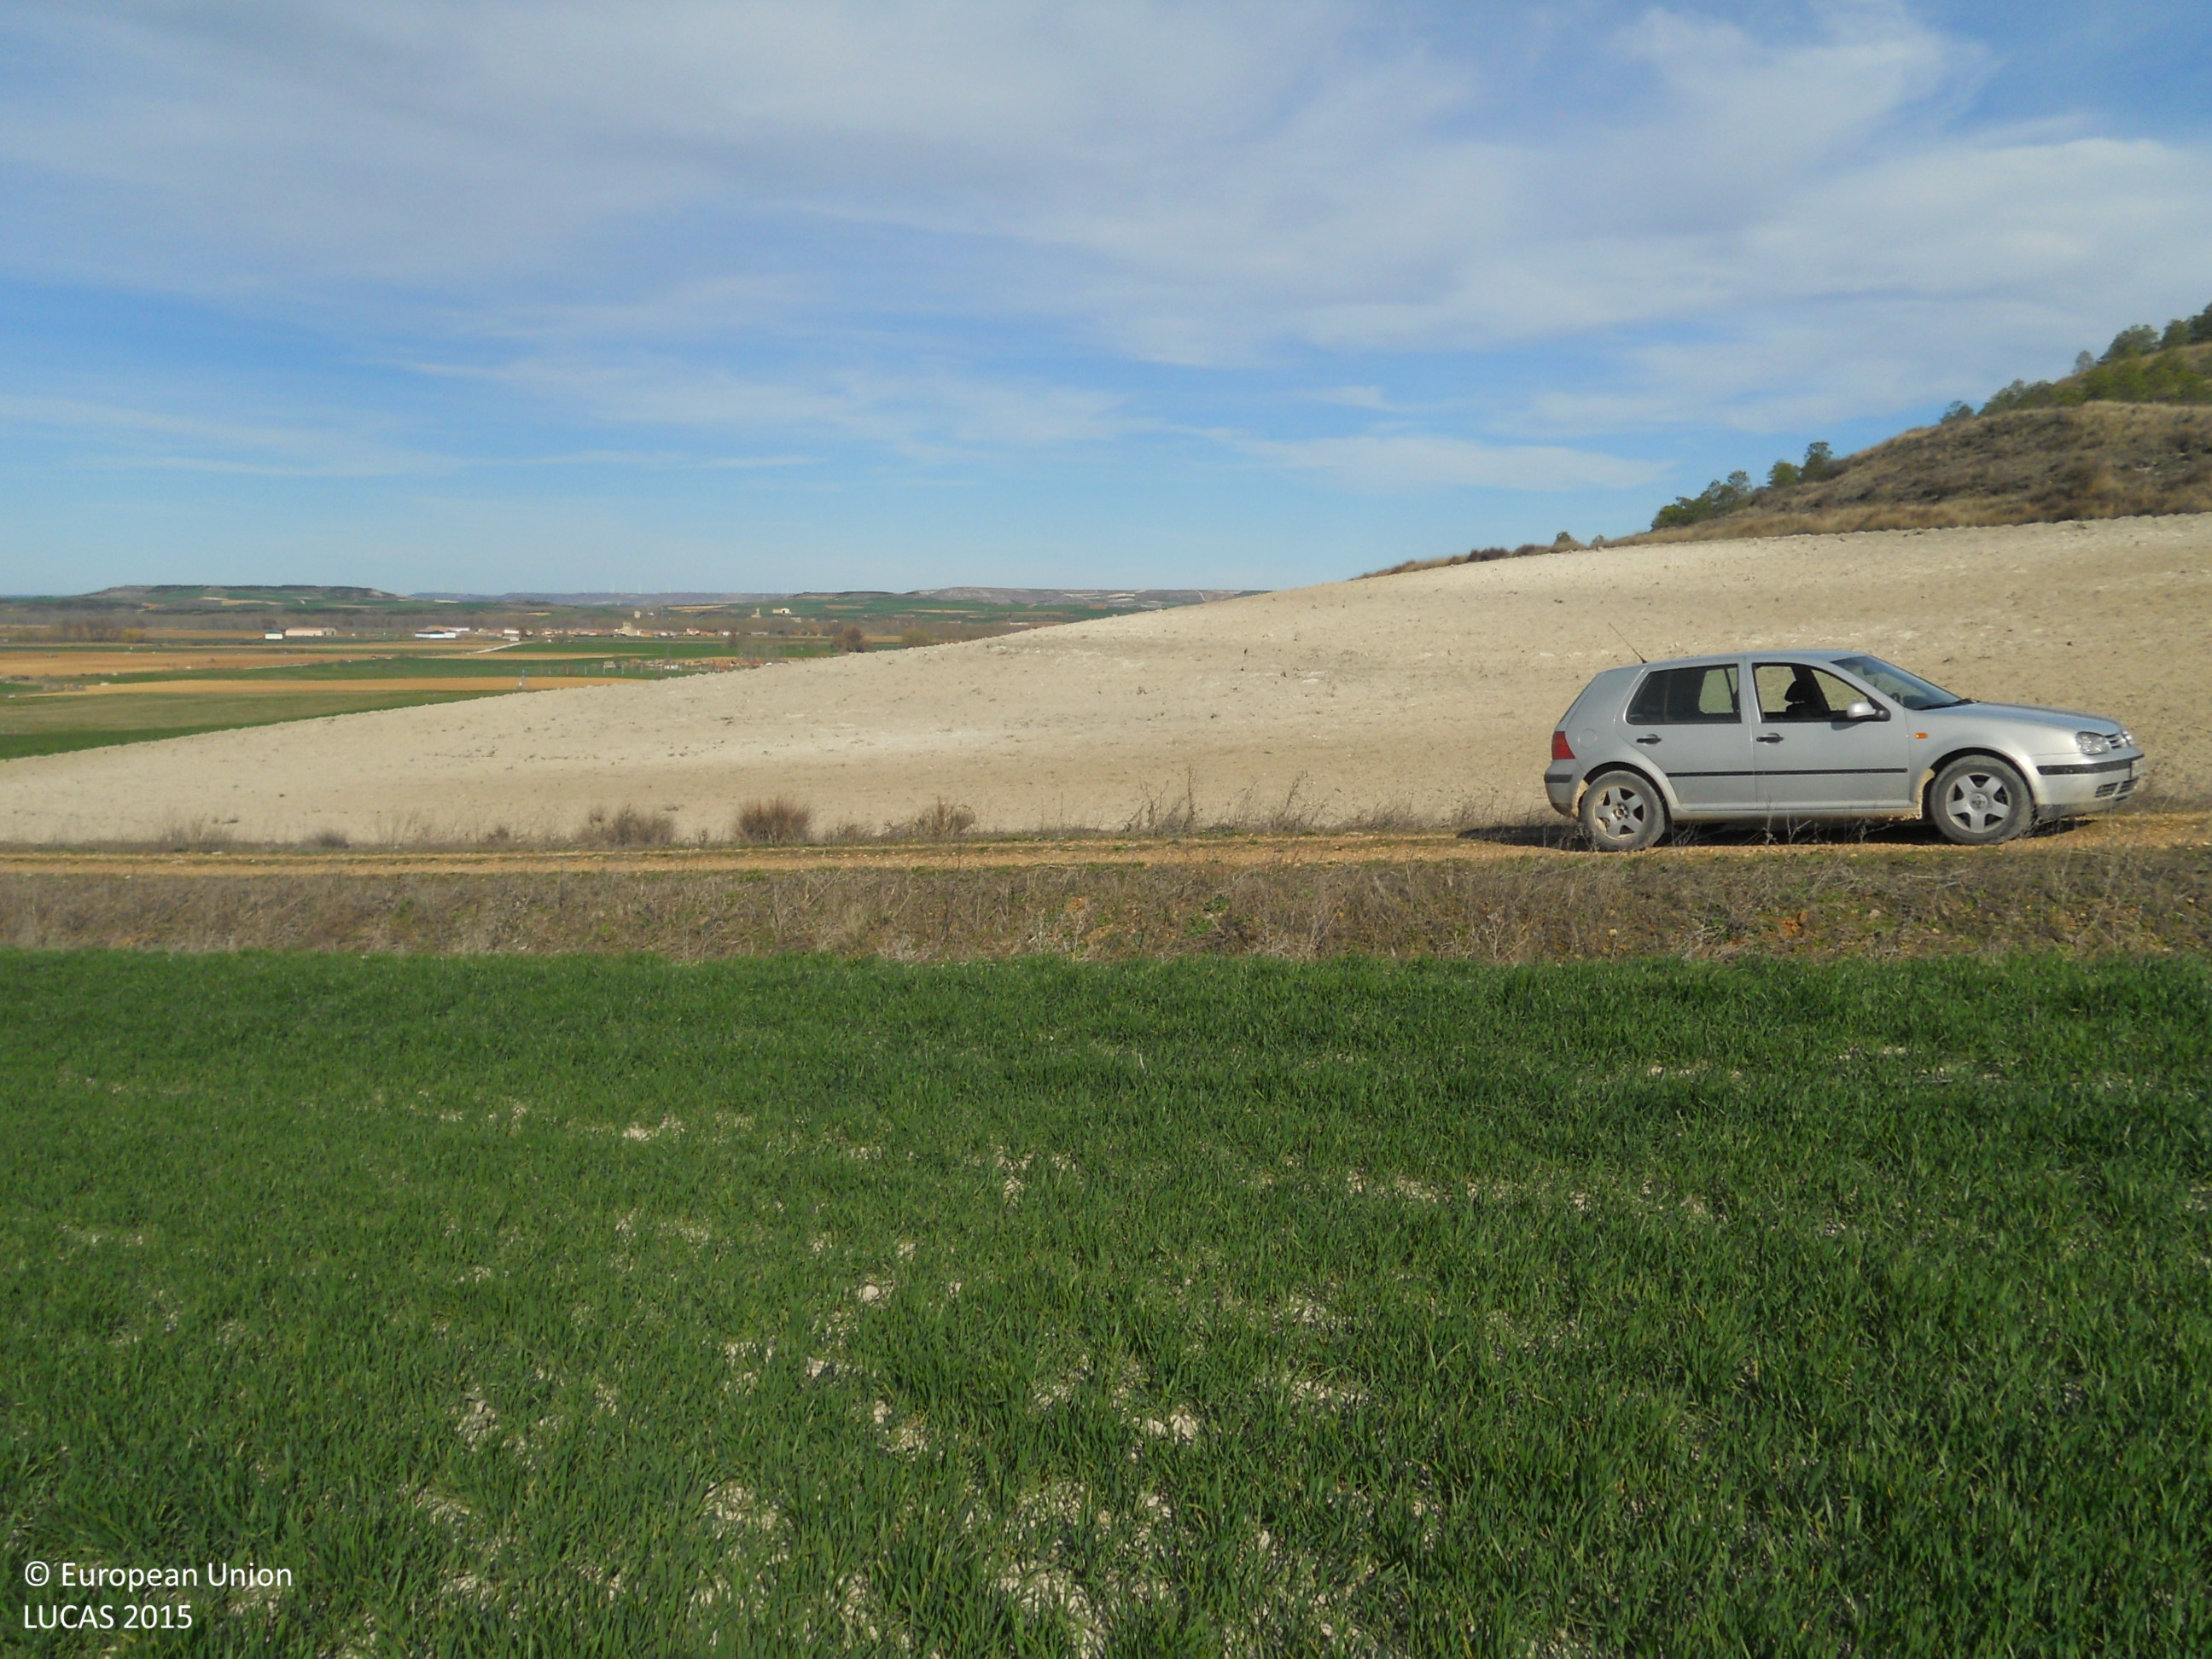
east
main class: Cropland
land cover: Barley
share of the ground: > 75 %
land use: Agriculture (excluding fallow land and kitchen gardens)
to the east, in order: Barley; Grass margins; Tracks; Grass margins; Other bare soil; Grassland without tree/shrub cover; Pine dominated coniferous woodland; Grass margins; Lucerne
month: April
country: ES
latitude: 42.2754
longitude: -4.2921
